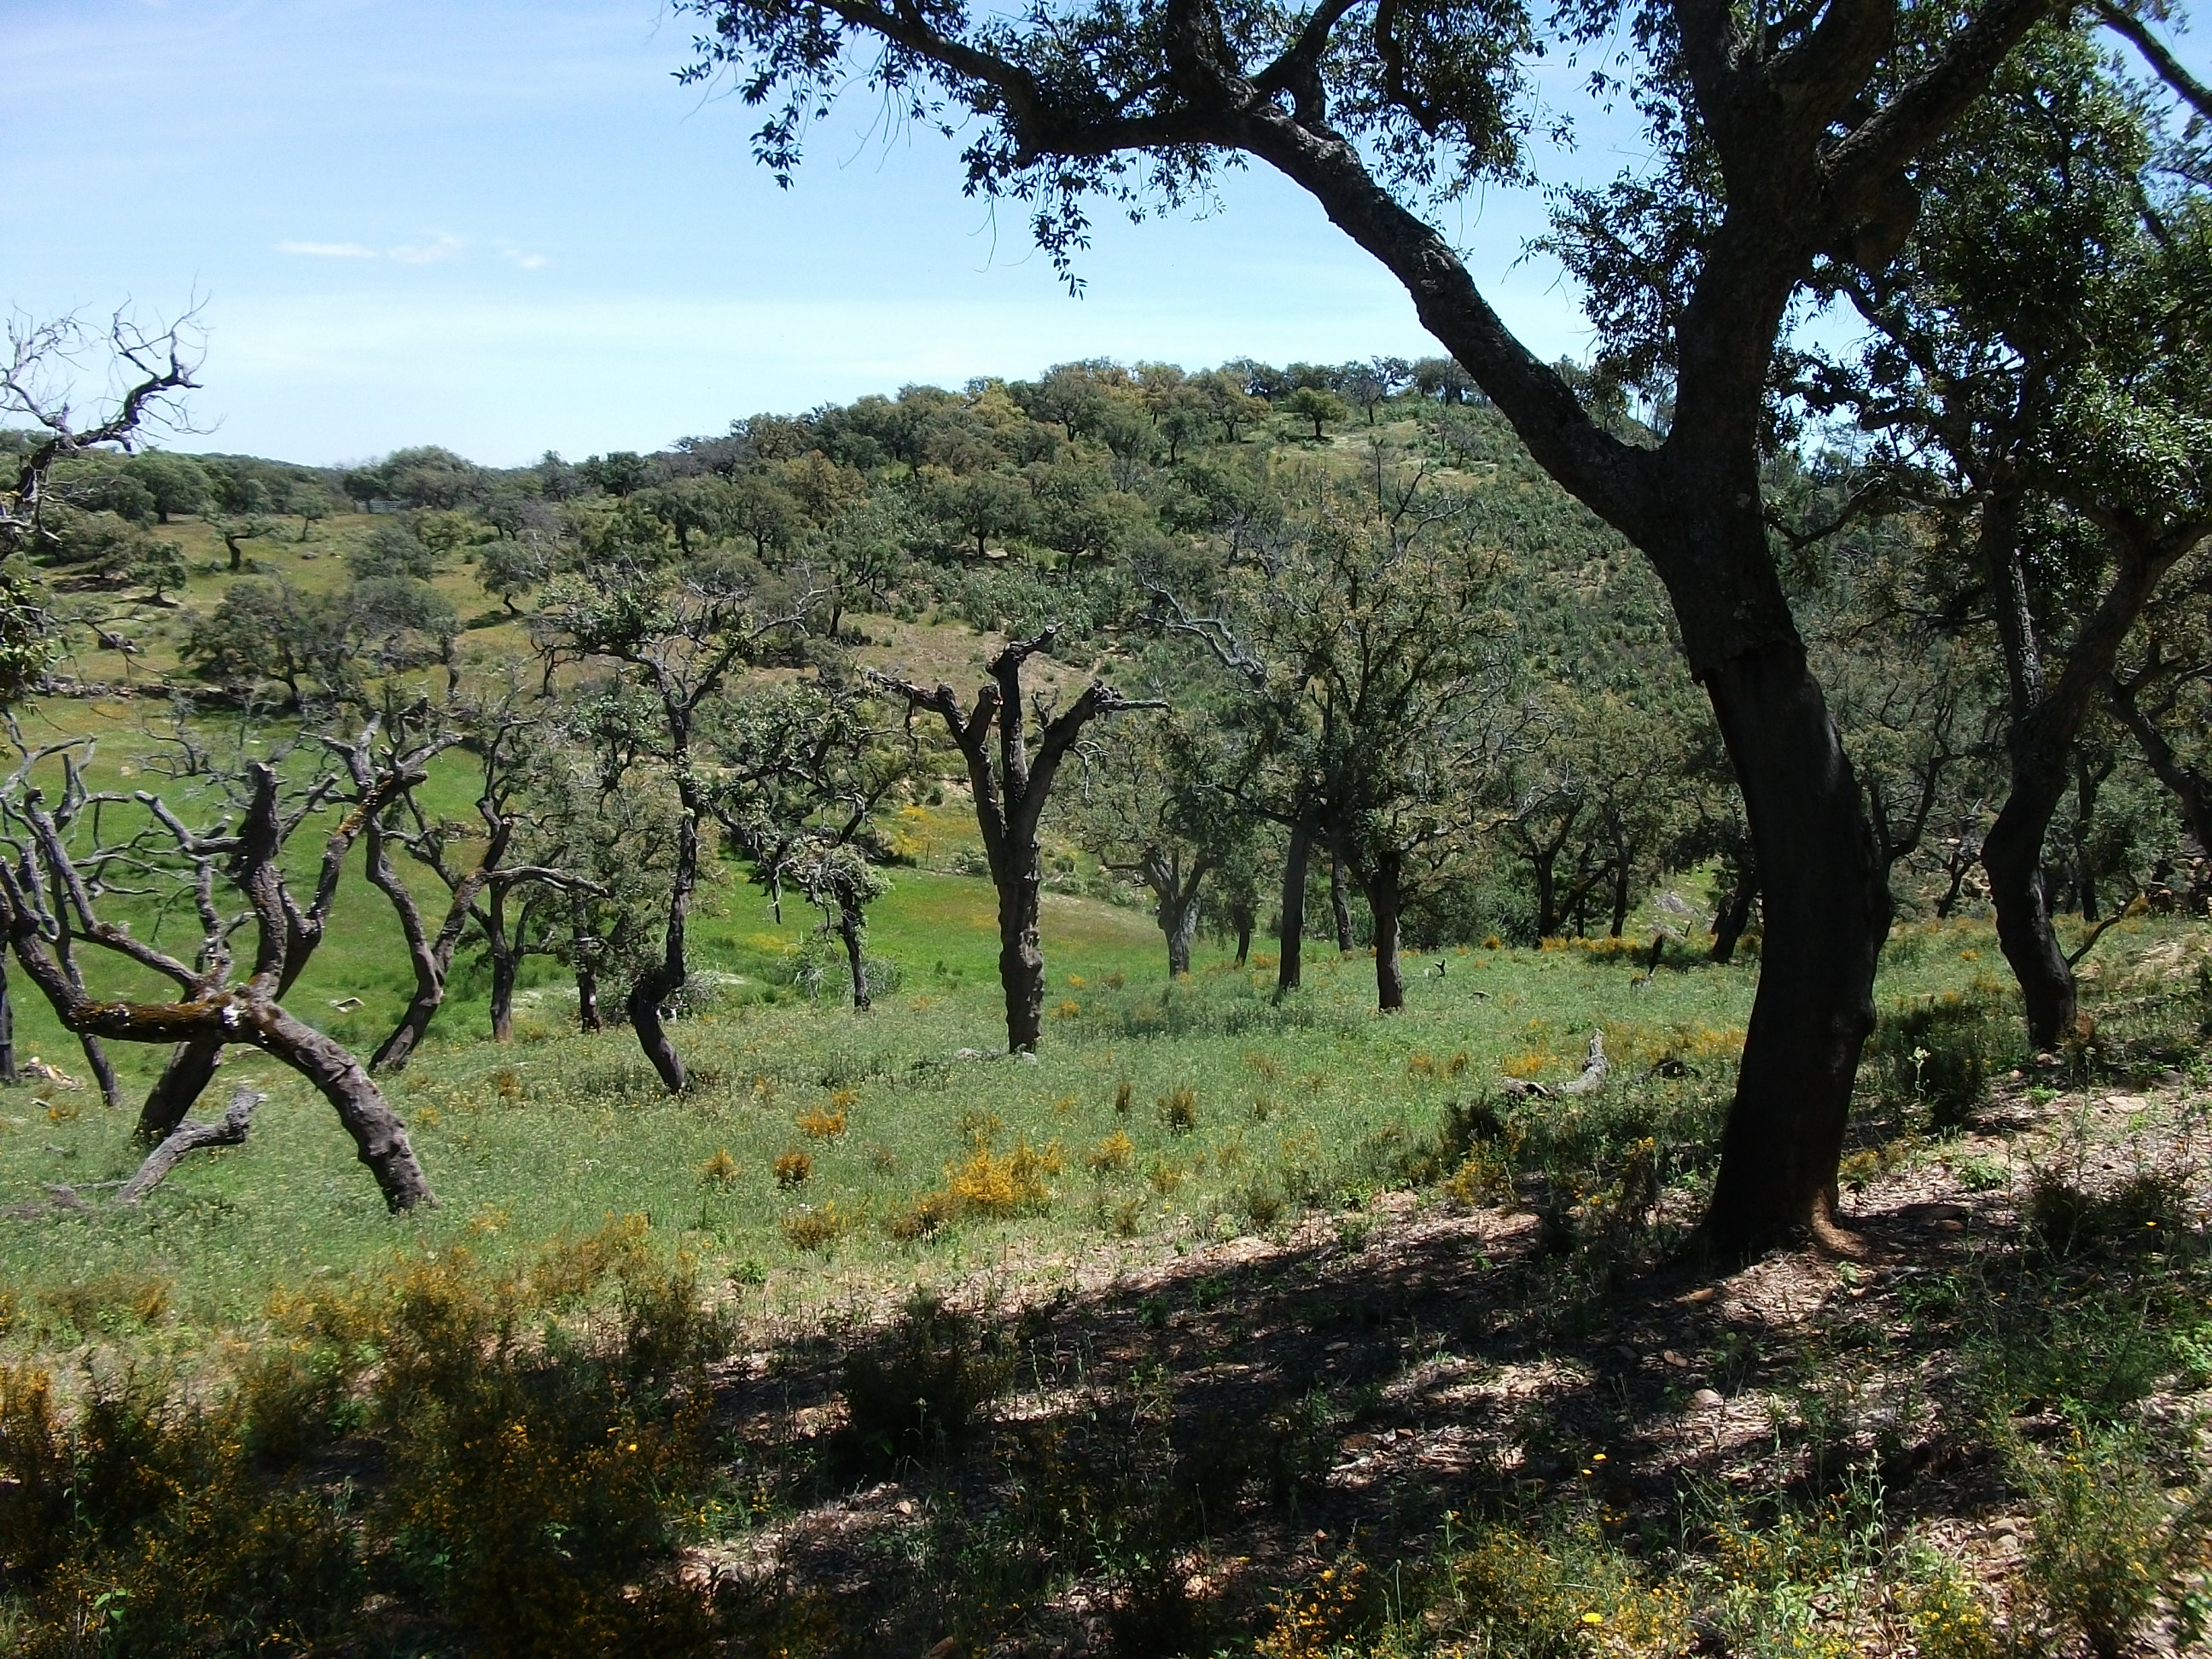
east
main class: Woodland
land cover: Broadleaved woodland
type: broadleaved evergreen forest
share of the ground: 50 - 75 %
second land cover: Spontaneously vegetated surfaces
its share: 10 - 25 %
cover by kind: broadleaved forest trees 70 %, herbaceous plants 20 %, shrubs 10 %
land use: Forestry
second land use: Agriculture (excluding fallow land and kitchen gardens)
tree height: > 5 m
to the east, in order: Broadleaved woodland; Spontaneously vegetated surfaces; Rivers and streams; Dry stone walls; Broadleaved woodland; Fences; Dry stone walls; Broadleaved woodland; Fences; Tracks; Shruby margins; Dry stone walls; Fences; Broadleaved woodland
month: April
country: ES
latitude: 37.7617
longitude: -6.5569
